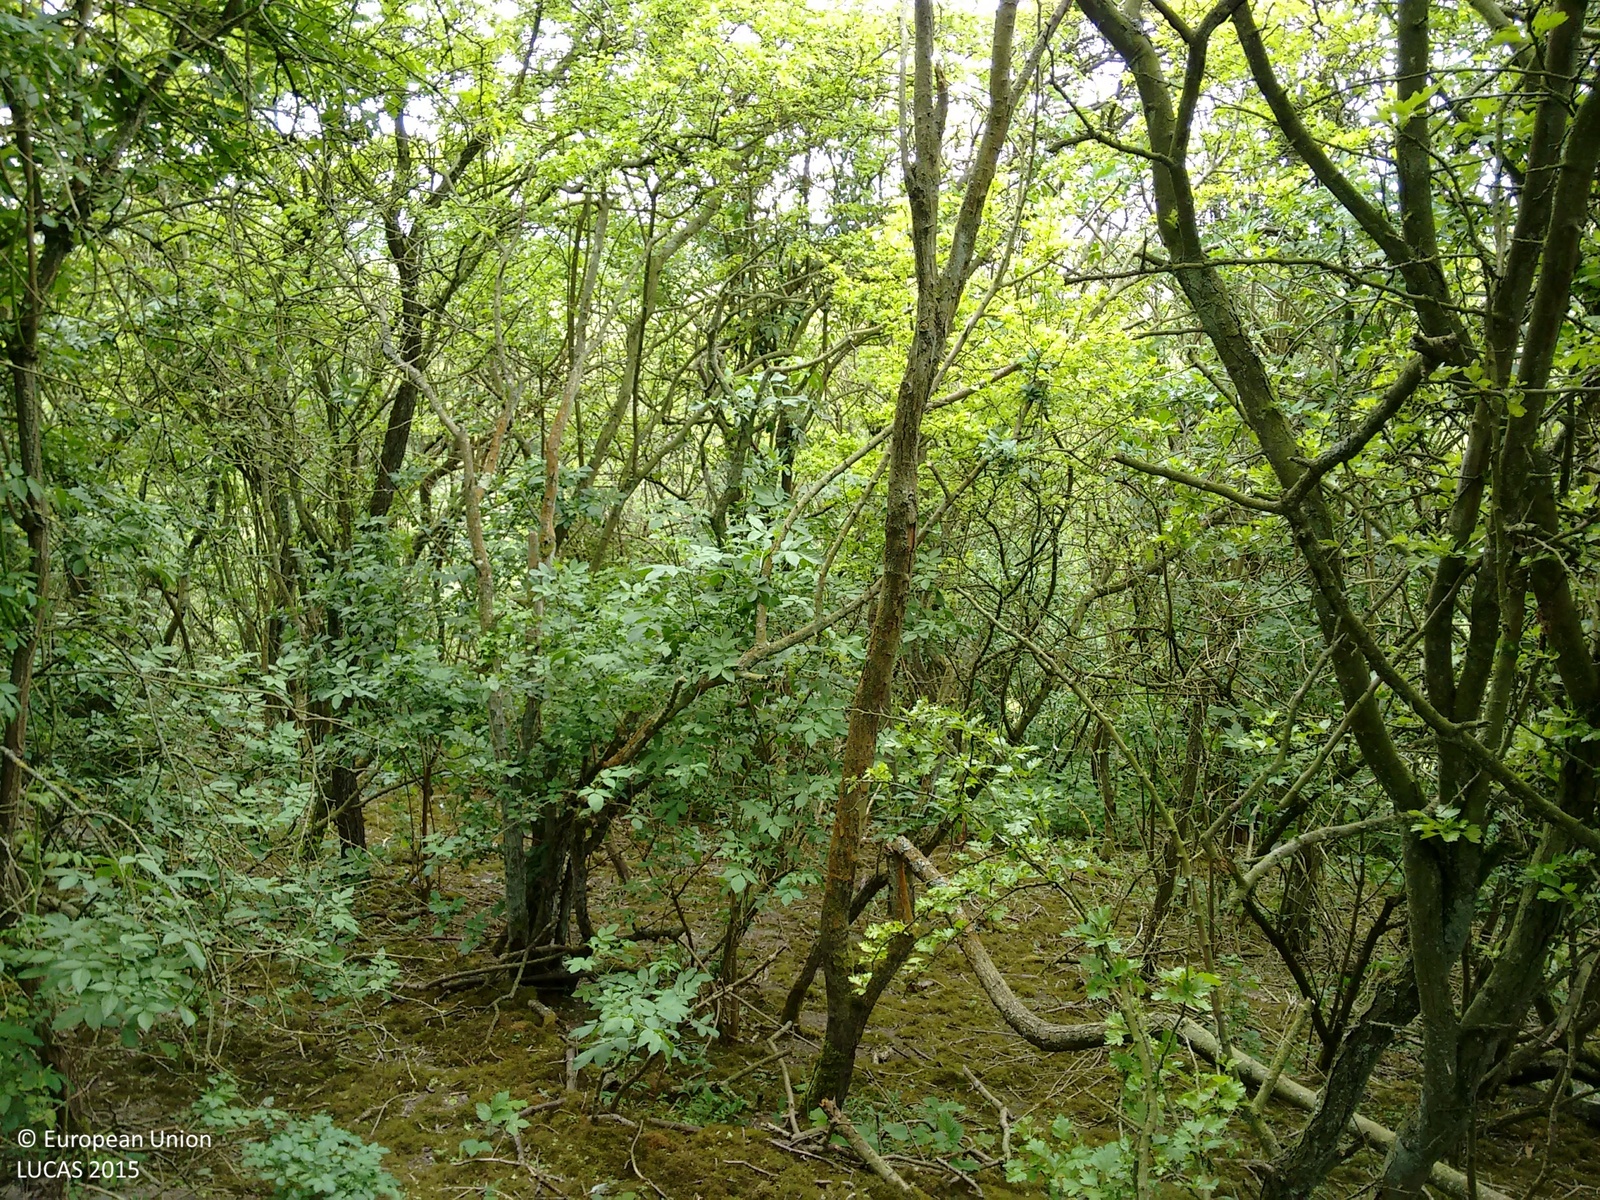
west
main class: Woodland
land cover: Broadleaved woodland
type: mesophytic deciduous forest
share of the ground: > 75 %
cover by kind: broadleaved forest trees 100 %
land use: Semi-natural and natural areas not in use
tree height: > 5 m
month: May
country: GB
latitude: 51.8706
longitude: -0.5396
